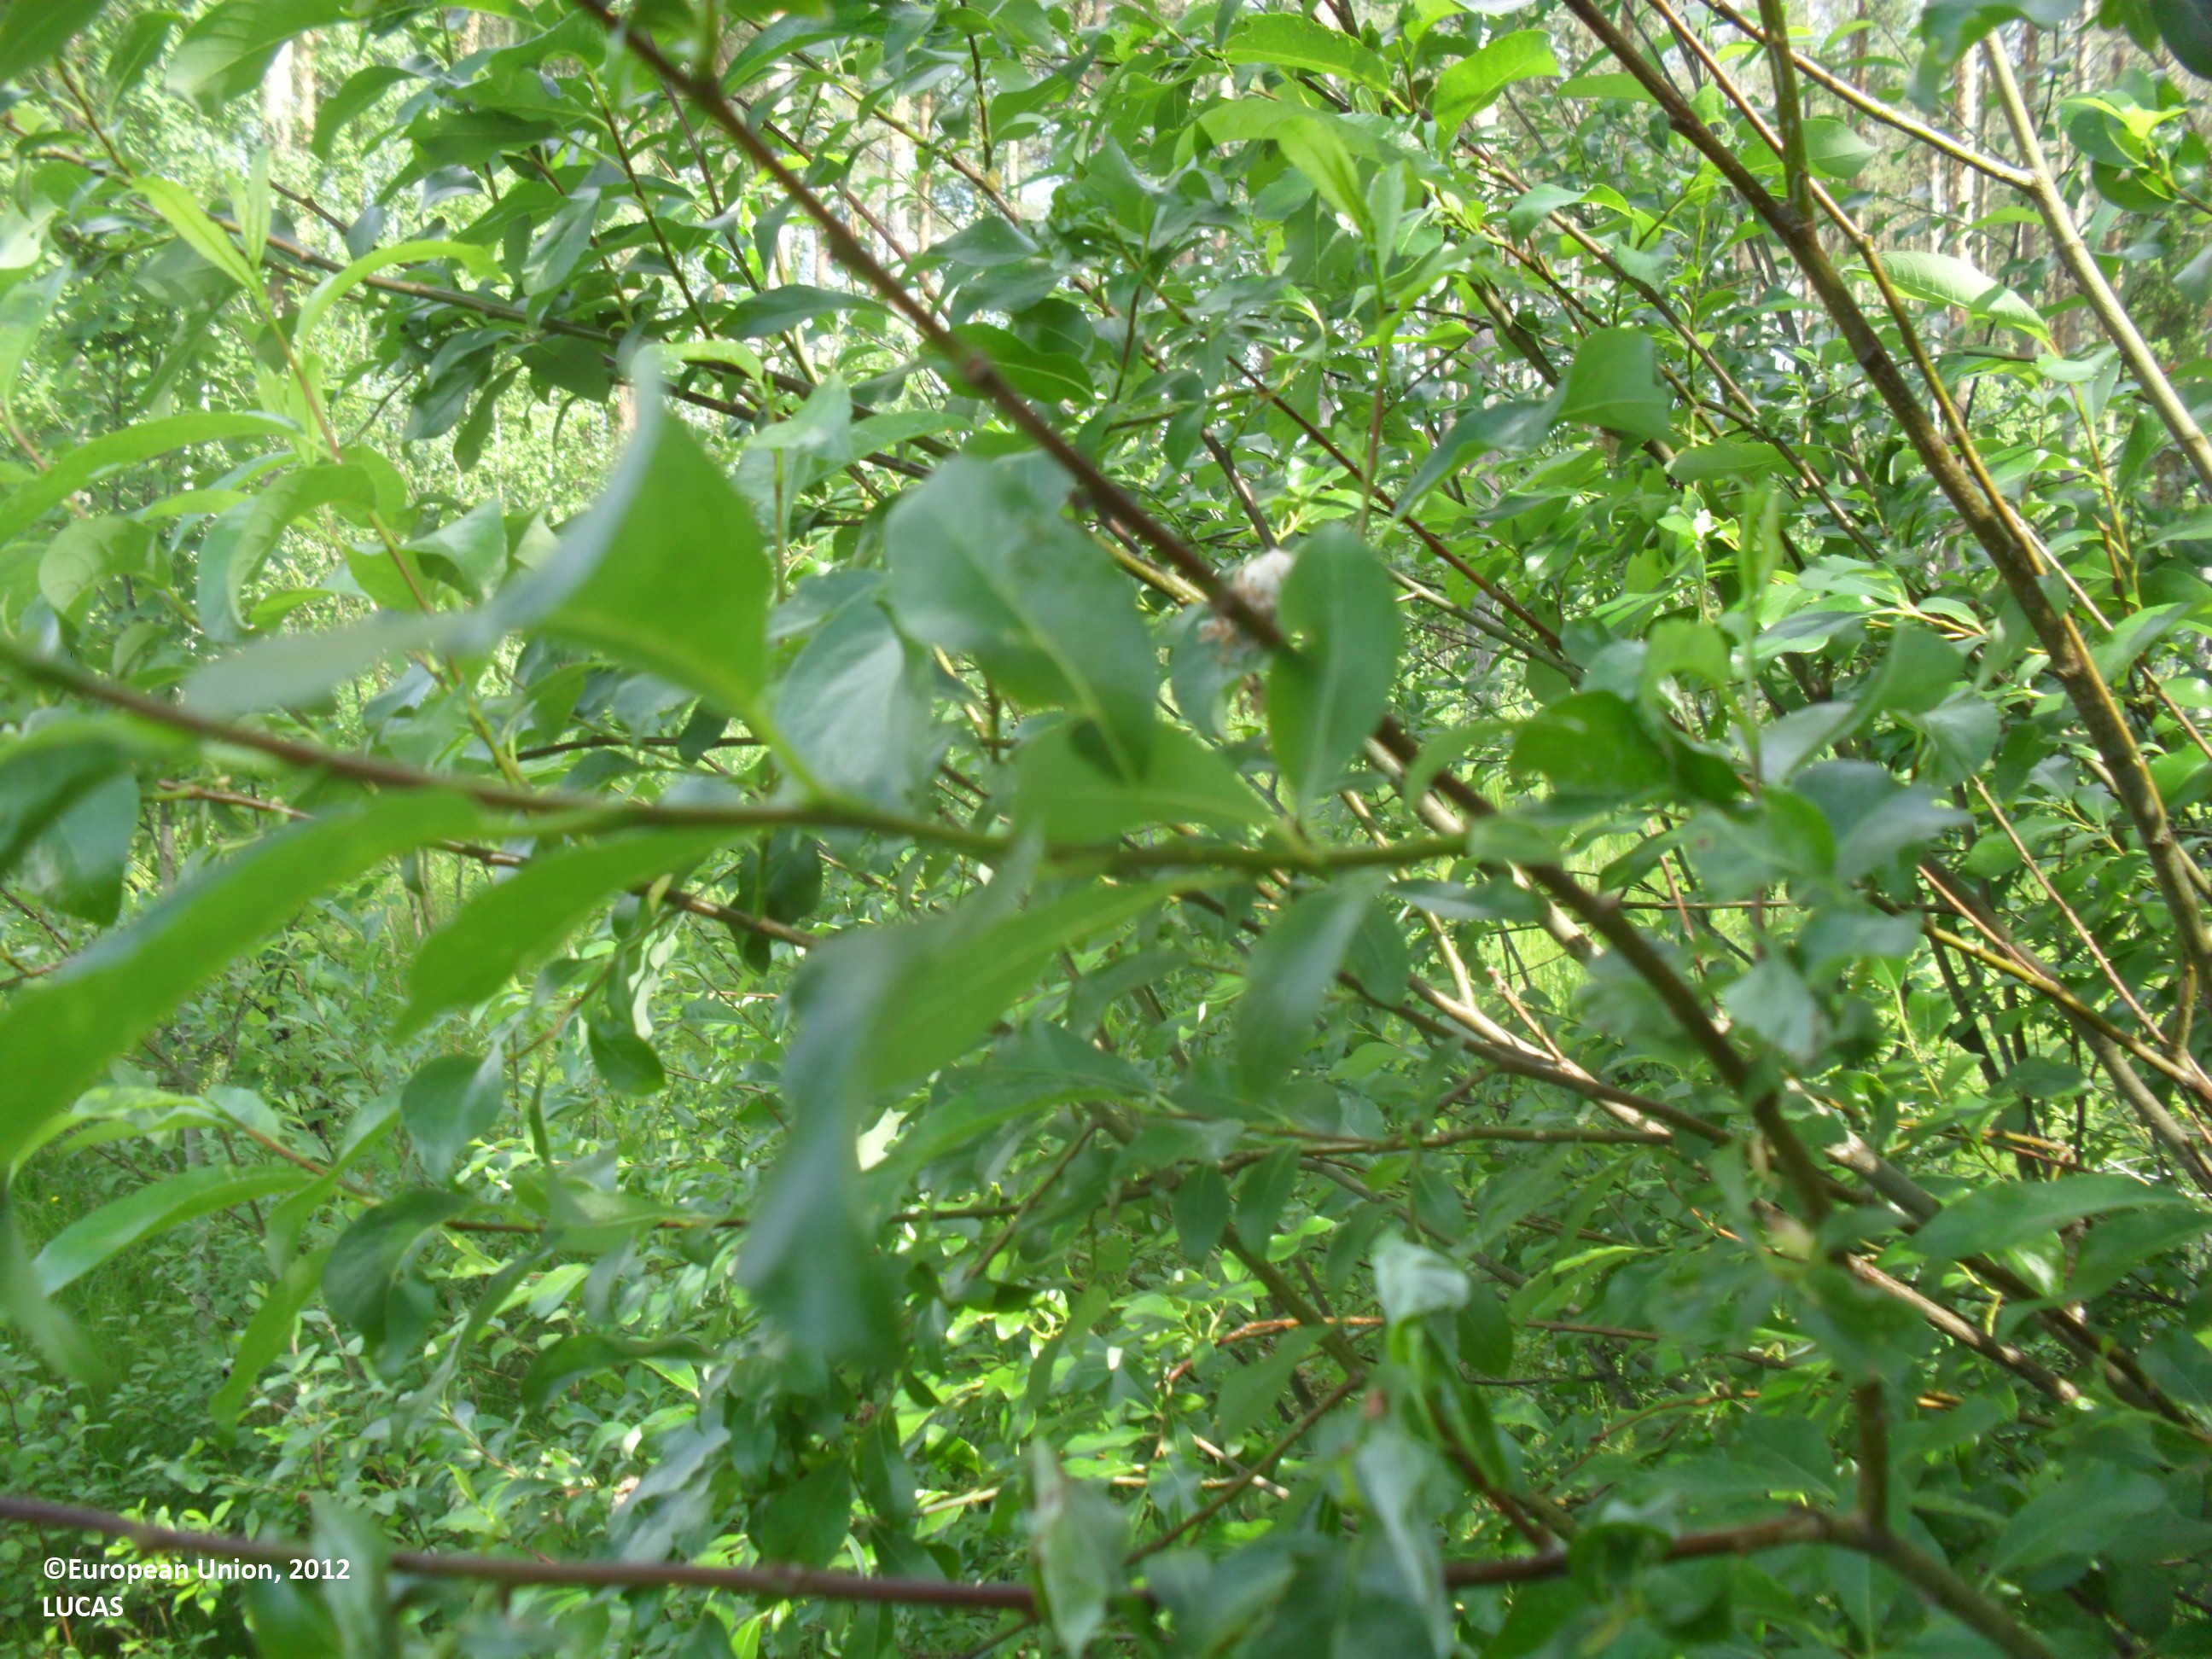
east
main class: Woodland
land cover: Pine dominated mixed woodland
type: boreal forest
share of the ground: 50 - 75 %
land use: Forestry
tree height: > 5 m
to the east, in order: Pine dominated mixed woodland; Grass margins; Ditches and canals; Pine dominated mixed woodland; Ditches and canals; Temporary grasslands; Abandoned hedges; Ditches and canals; Dry pulses
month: July
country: FI
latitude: 63.4563
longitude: 23.8475
